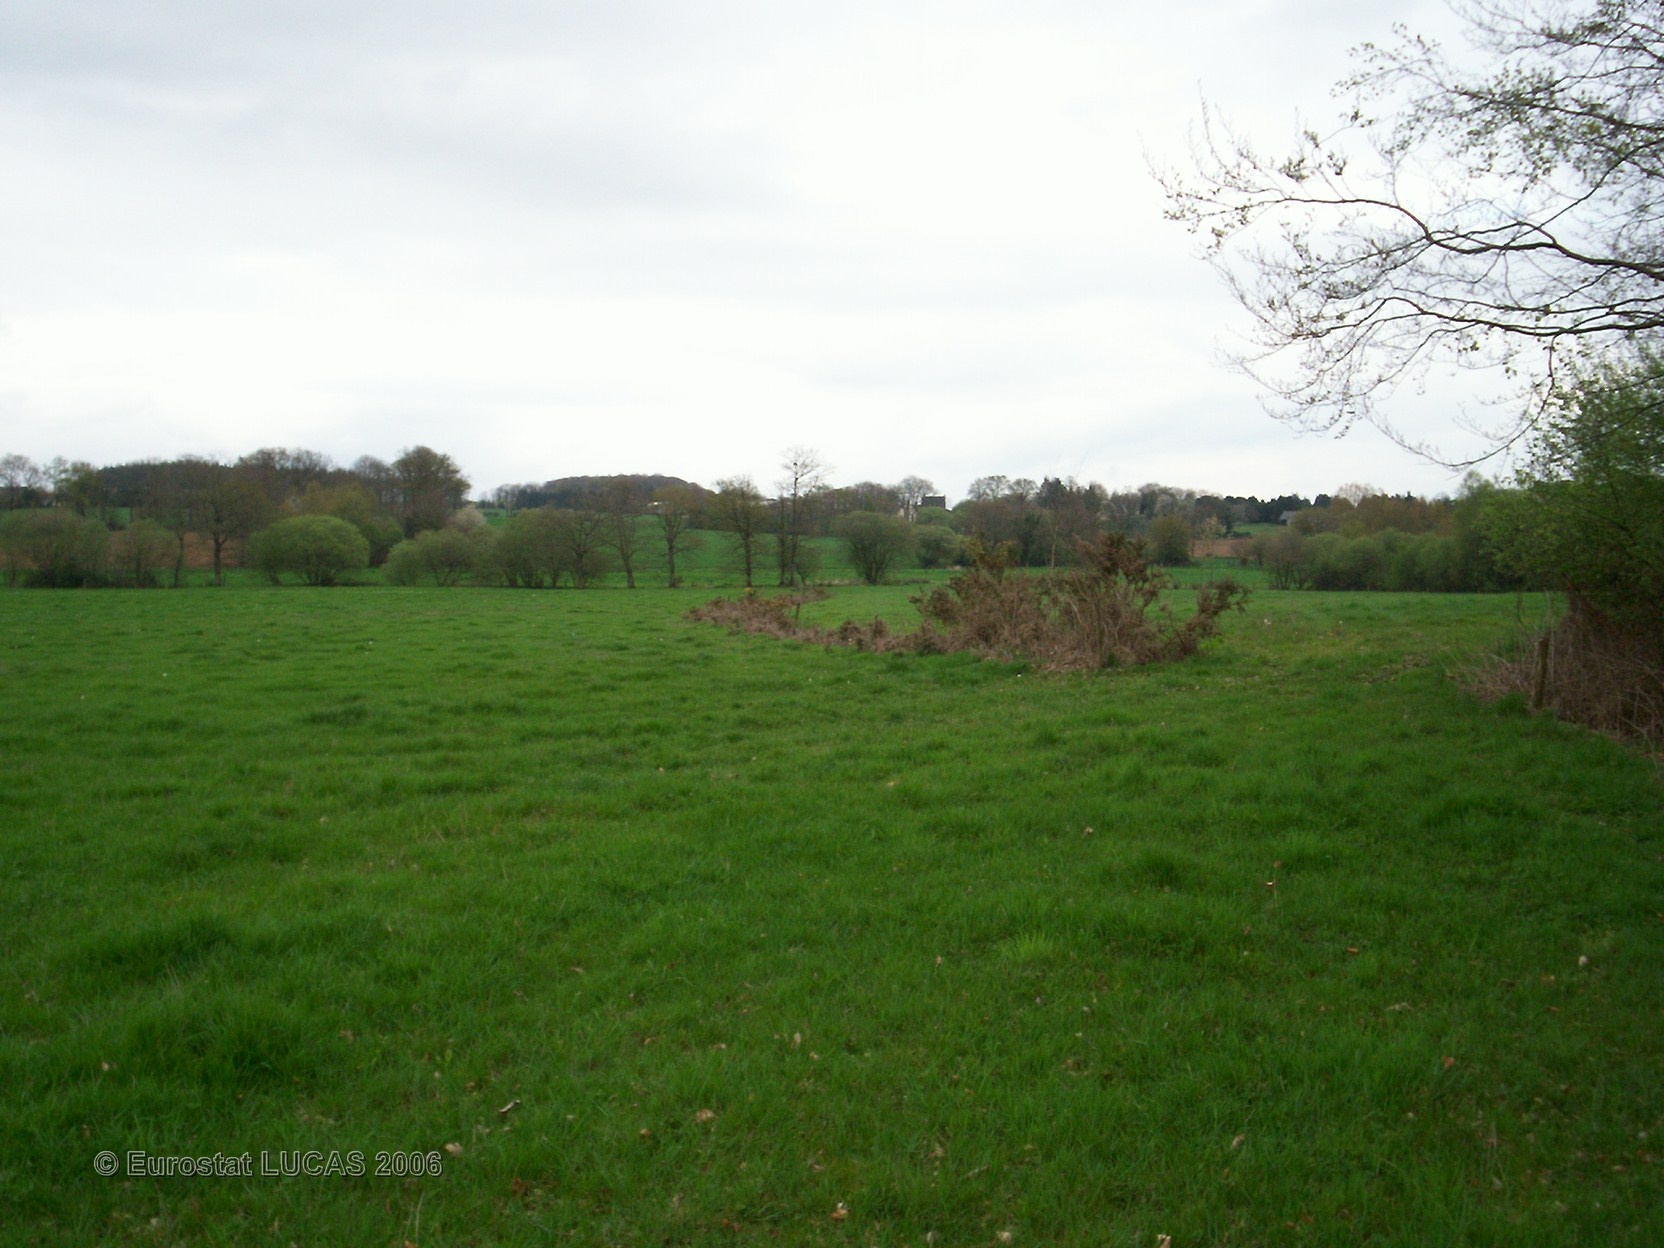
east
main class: Grassland
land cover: Grassland without tree/shrub cover
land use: Agriculture (excluding fallow land and kitchen gardens)
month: April
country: FR
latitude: 48.0821
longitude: -2.4221
